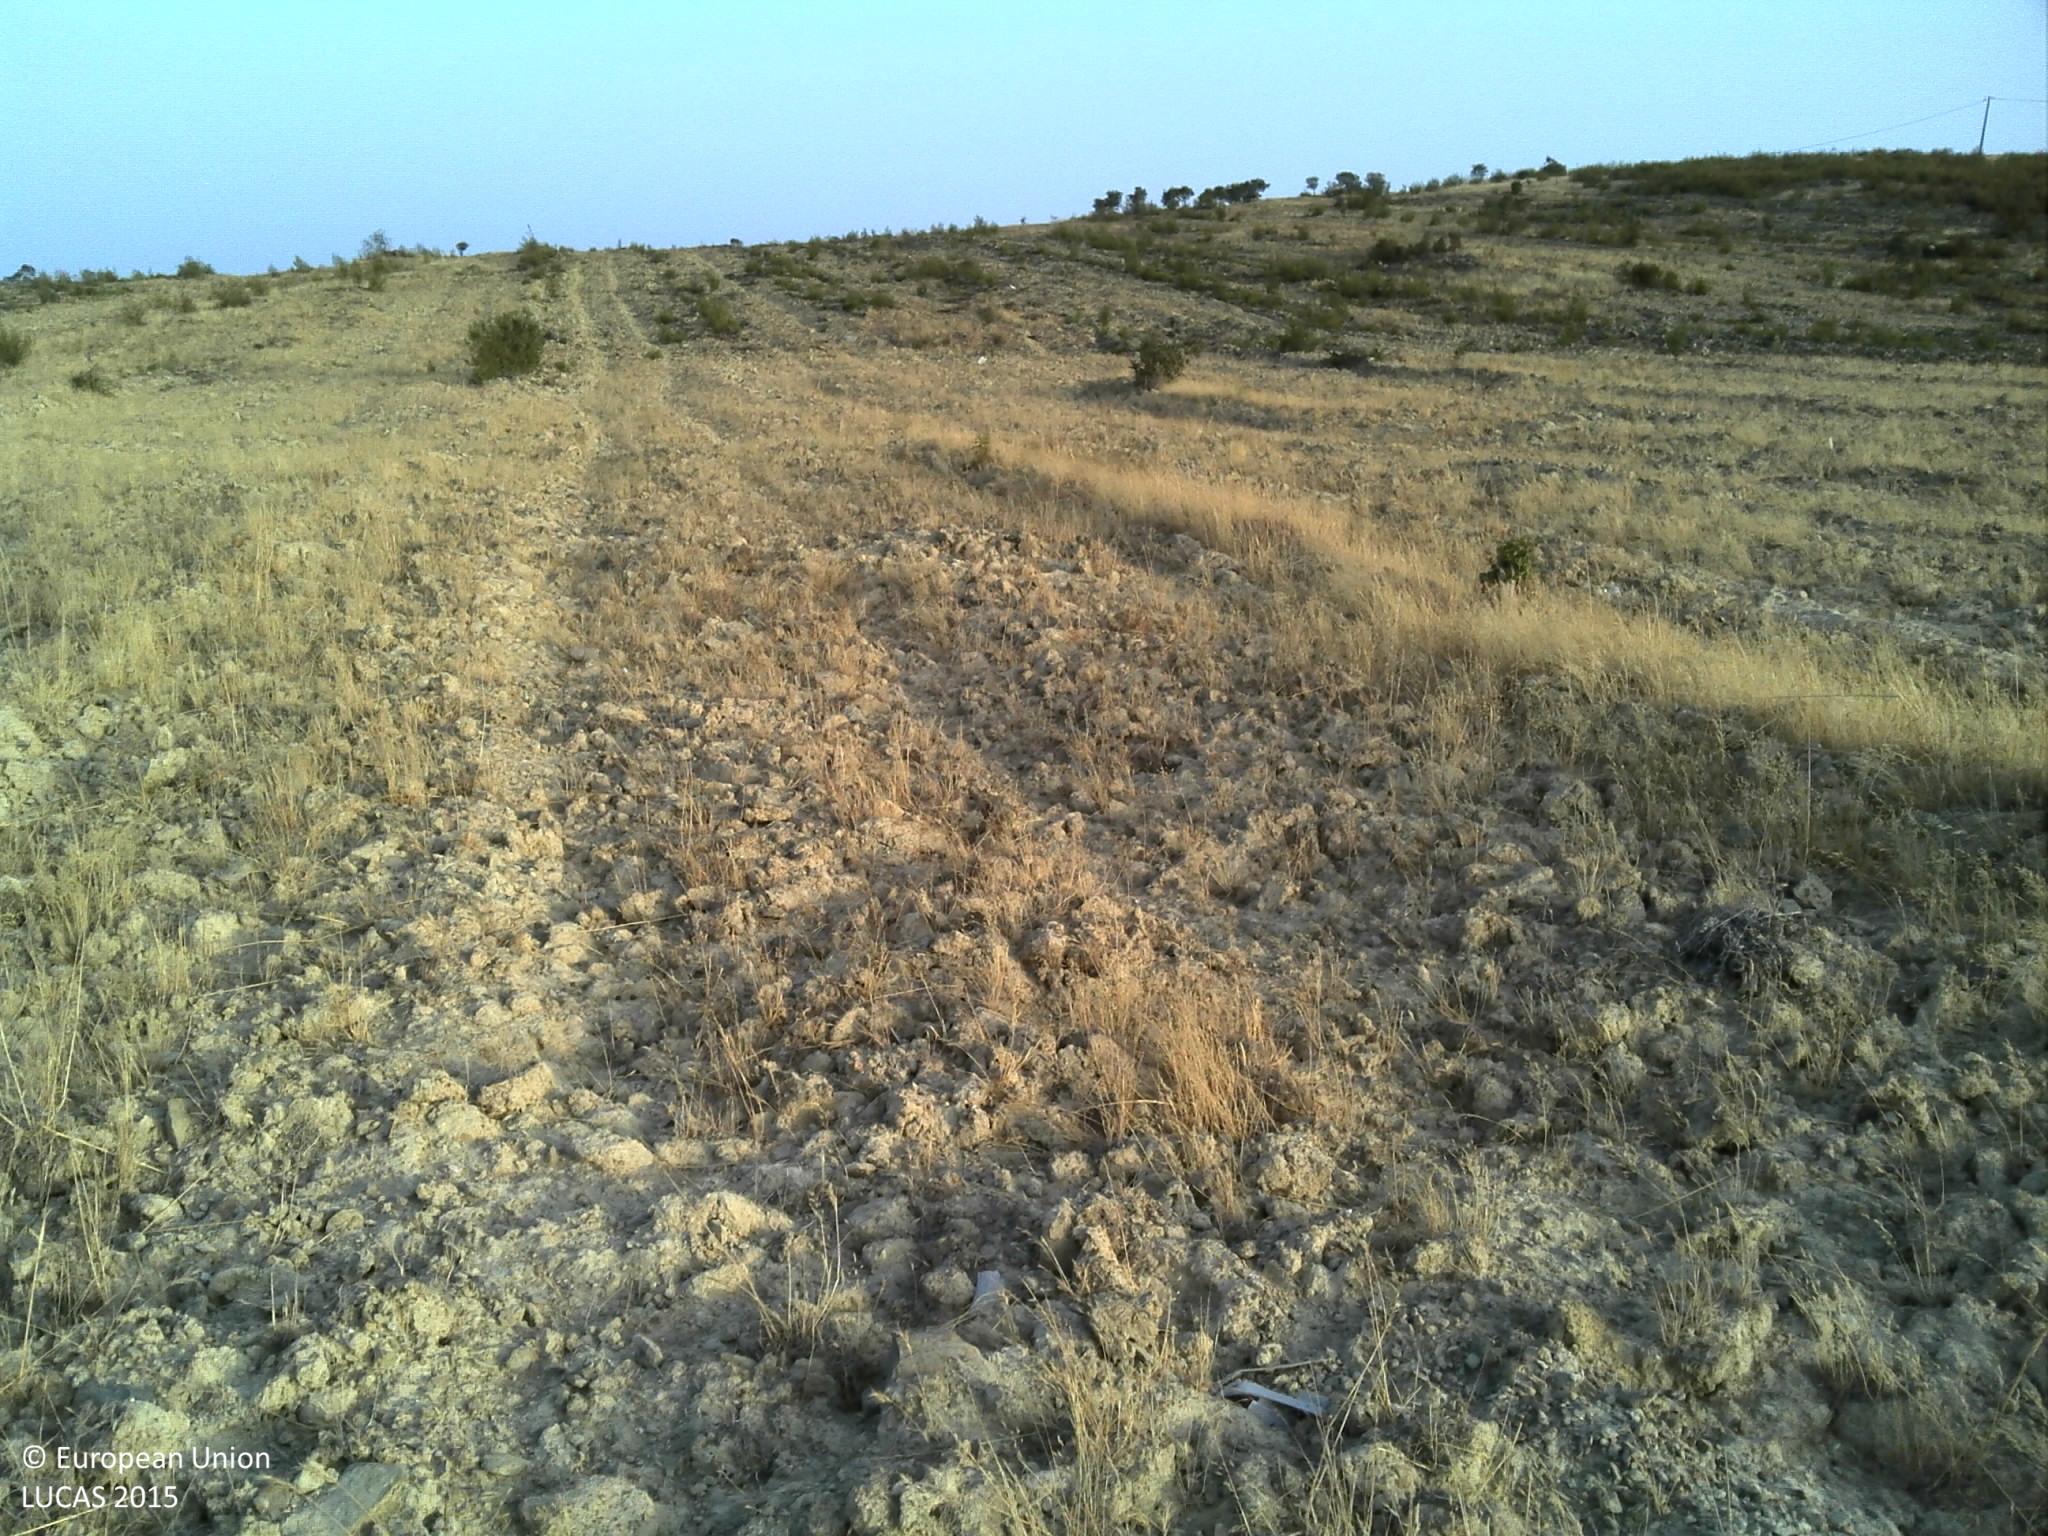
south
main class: Grassland
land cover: Grassland with sparse tree/shrub cover
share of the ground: 50 - 75 %
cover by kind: unconsolidated bare surface 80 %, herbaceous plants 15 %, broadleaved forest trees 5 %
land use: Forestry
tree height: < 5 m
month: July
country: PT
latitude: 37.5491
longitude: -7.9147
